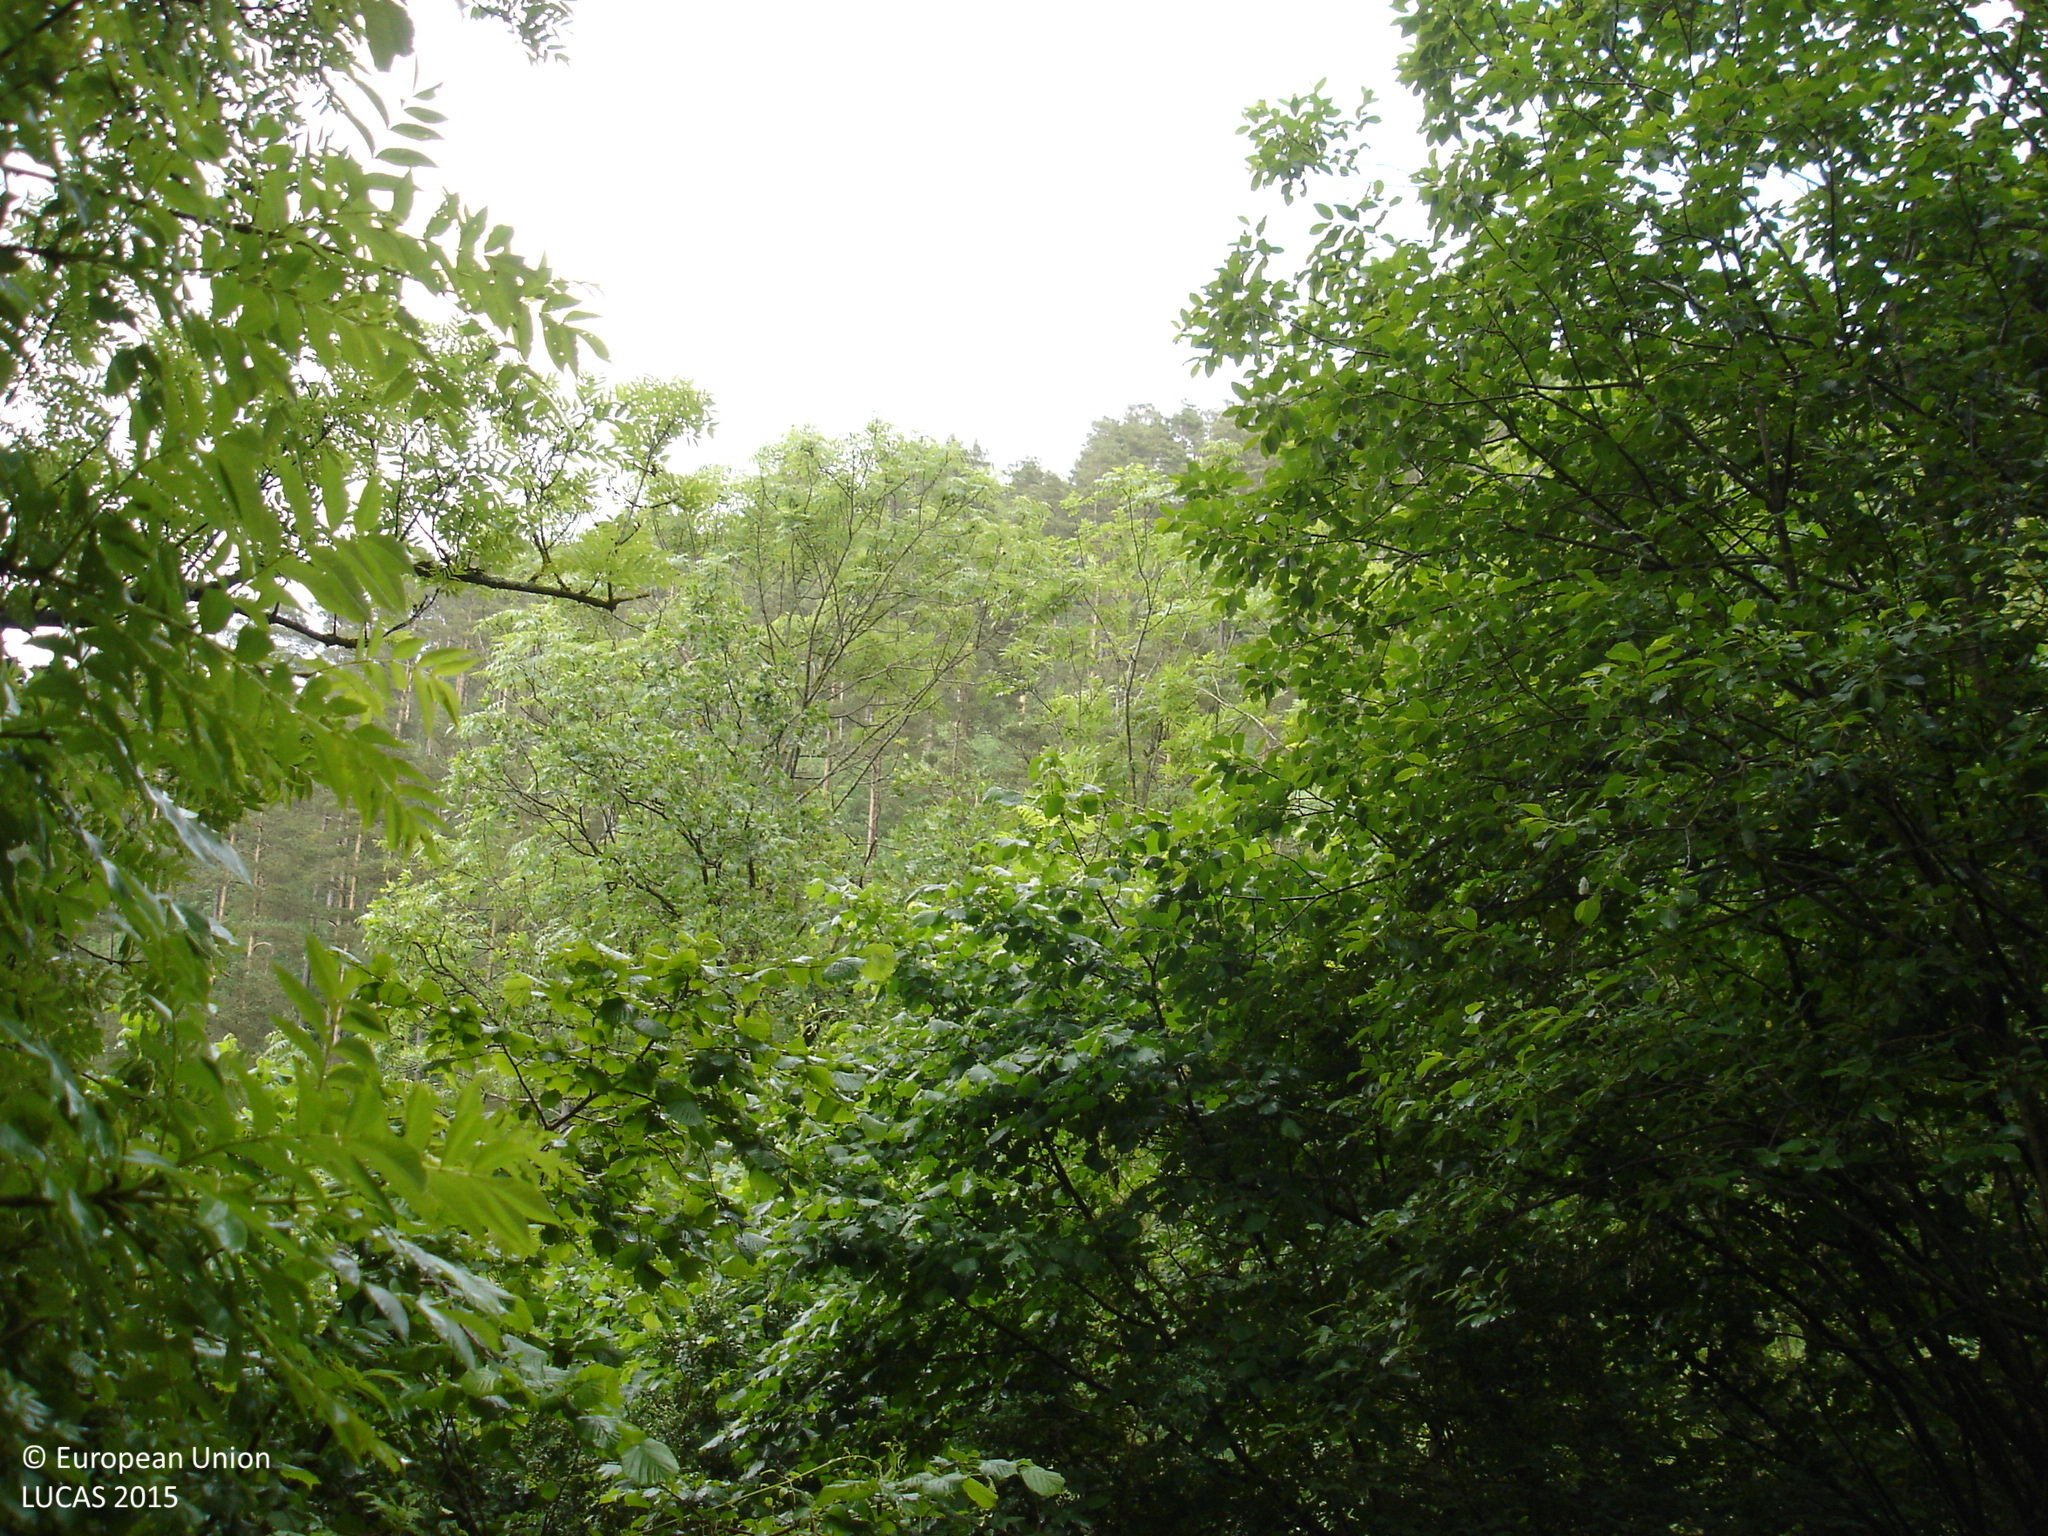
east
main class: Woodland
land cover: Broadleaved woodland
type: thermophilous deciduous forest
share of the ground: > 75 %
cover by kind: broadleaved forest trees 90 %, herbaceous plants 5 %, consolidated bare surface 5 %
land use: Forestry
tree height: > 5 m
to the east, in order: Broadleaved woodland; Rivers and streams; Broadleaved woodland; Pine dominated coniferous woodland; Tracks; Pine dominated coniferous woodland; Other mixed woodland
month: June
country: ES
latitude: 42.3100
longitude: 2.1145
